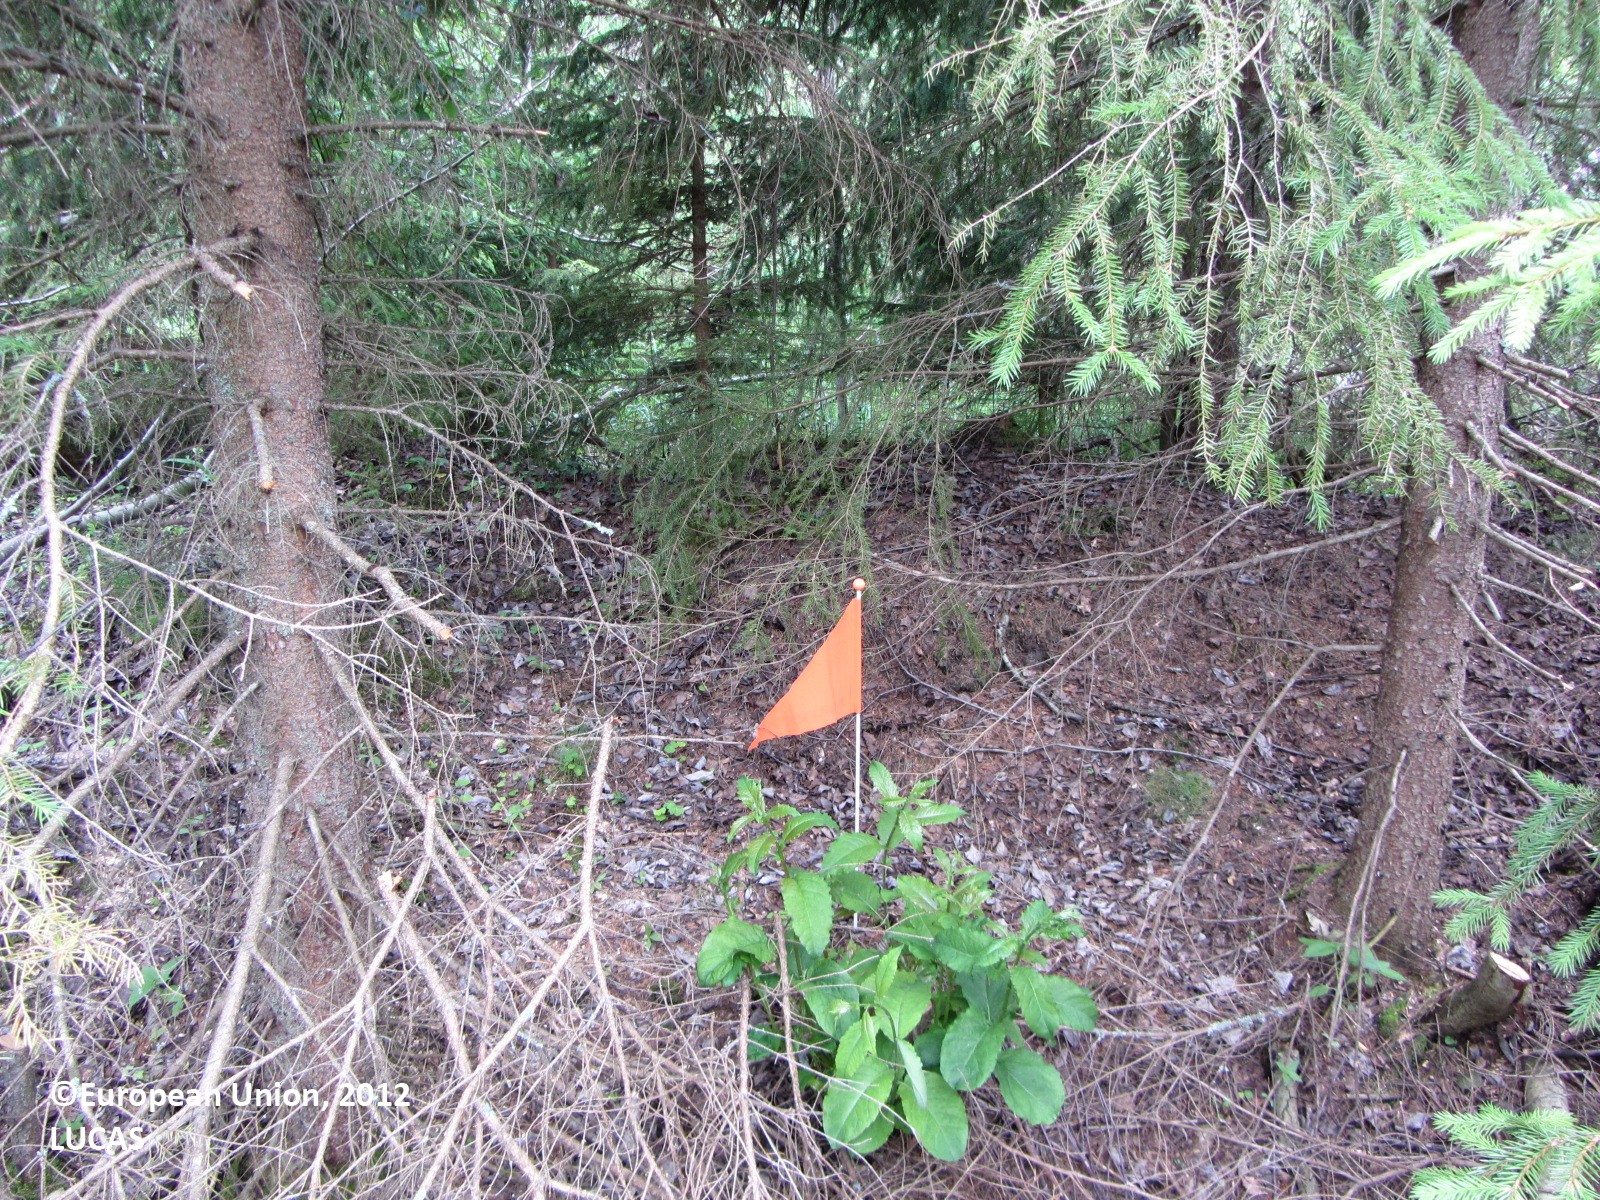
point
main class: Woodland
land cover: Other mixed woodland
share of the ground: 50 - 75 %
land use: Forestry
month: June
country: FI
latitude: 62.6312
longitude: 25.3347
